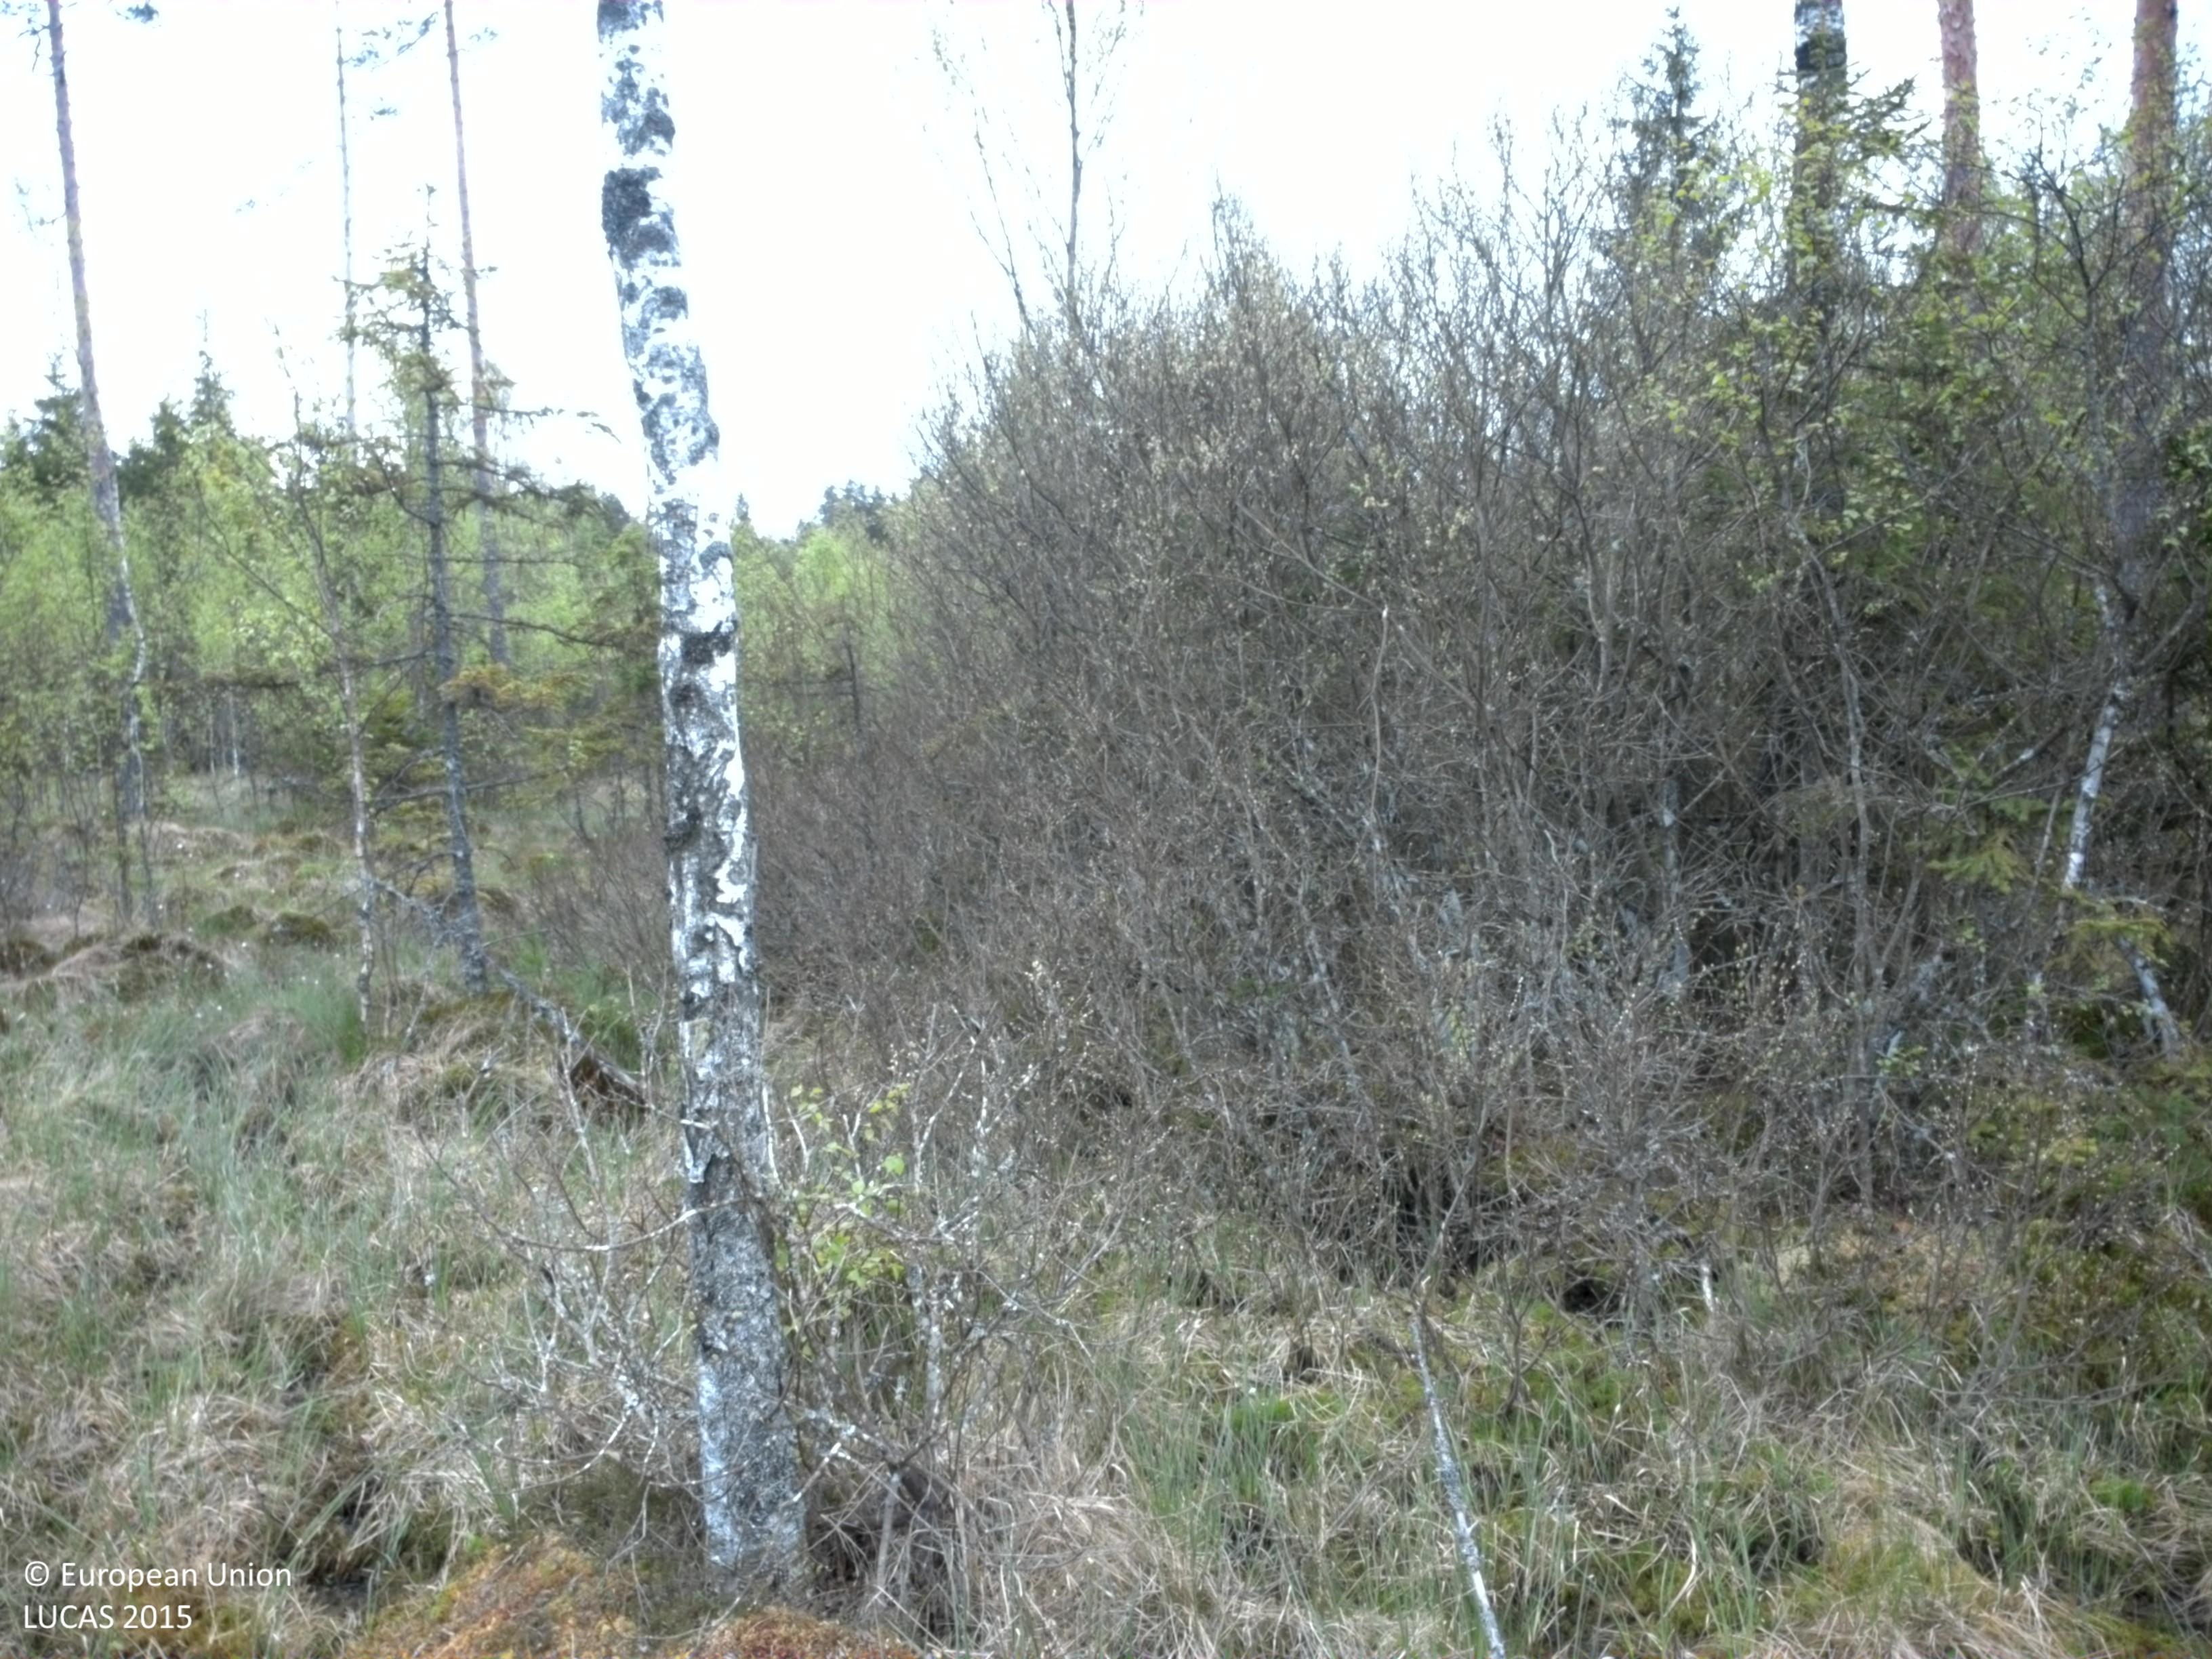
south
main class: Woodland
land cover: Broadleaved woodland
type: hemiboreal forest and nemoral coniferous forest and mixed broadleaved-coniferous forest
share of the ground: 25 - 50 %
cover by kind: broadleaved forest trees 40 %, herbaceous plants 30 %, lichens and mosses 30 %
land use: Forestry
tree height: > 5 m
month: May
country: SE
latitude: 56.8109
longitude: 15.4527
